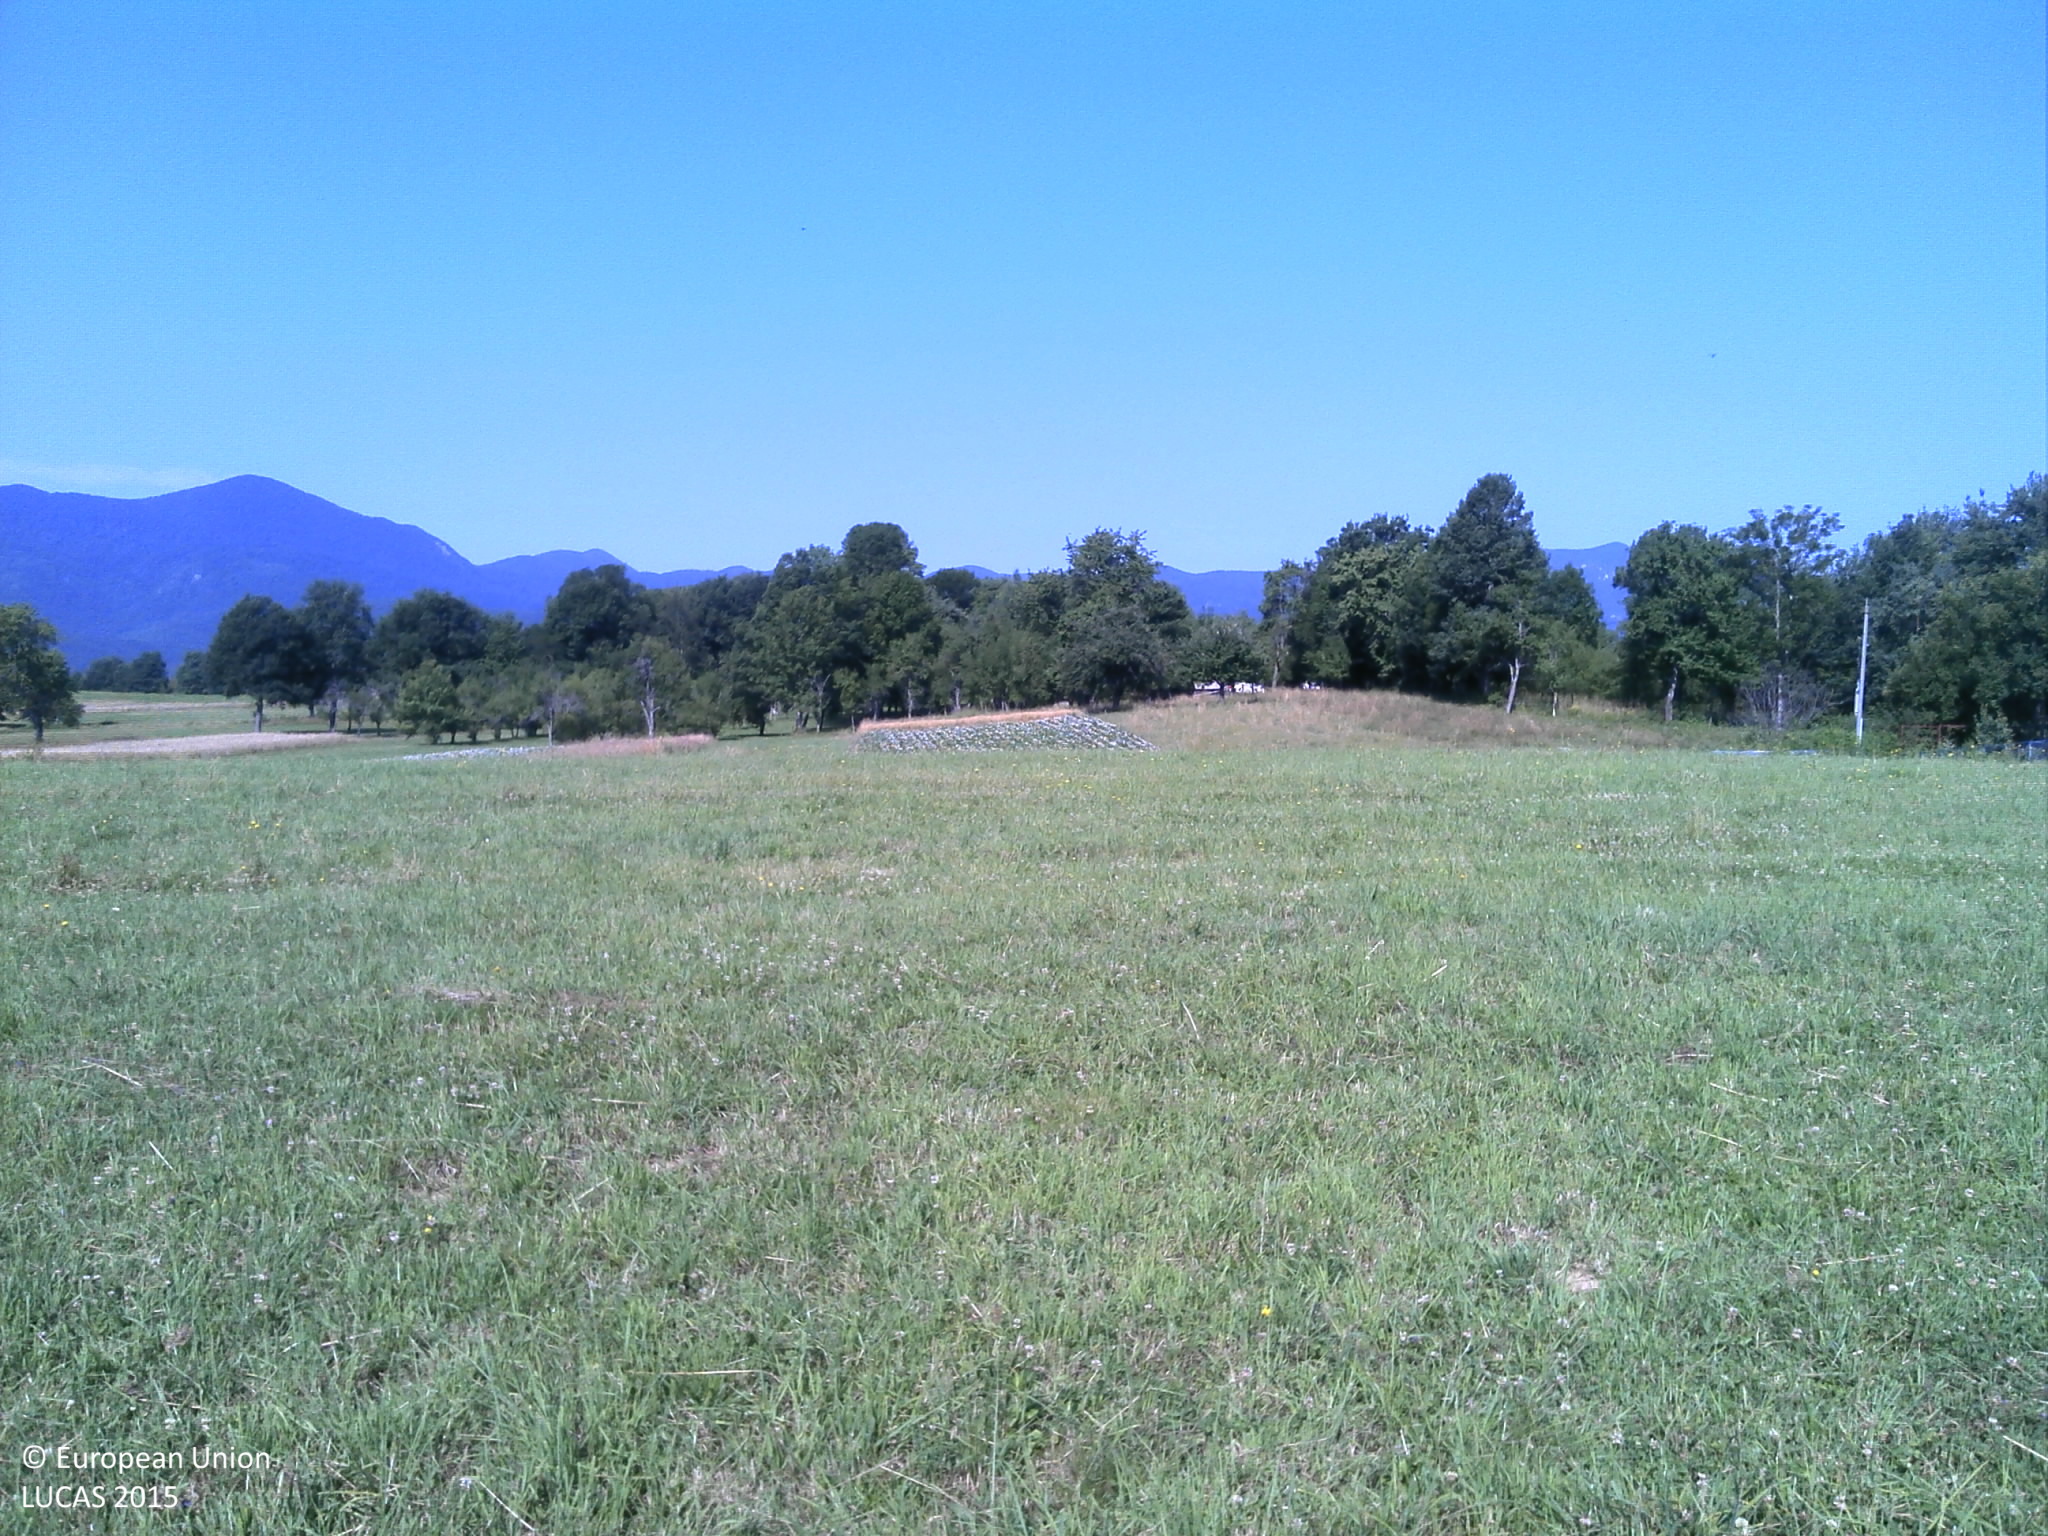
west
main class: Grassland
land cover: Grassland without tree/shrub cover
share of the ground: > 75 %
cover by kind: herbaceous plants 100 %
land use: Agriculture (excluding fallow land and kitchen gardens)
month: July
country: HR
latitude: 44.6345
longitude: 15.2250
